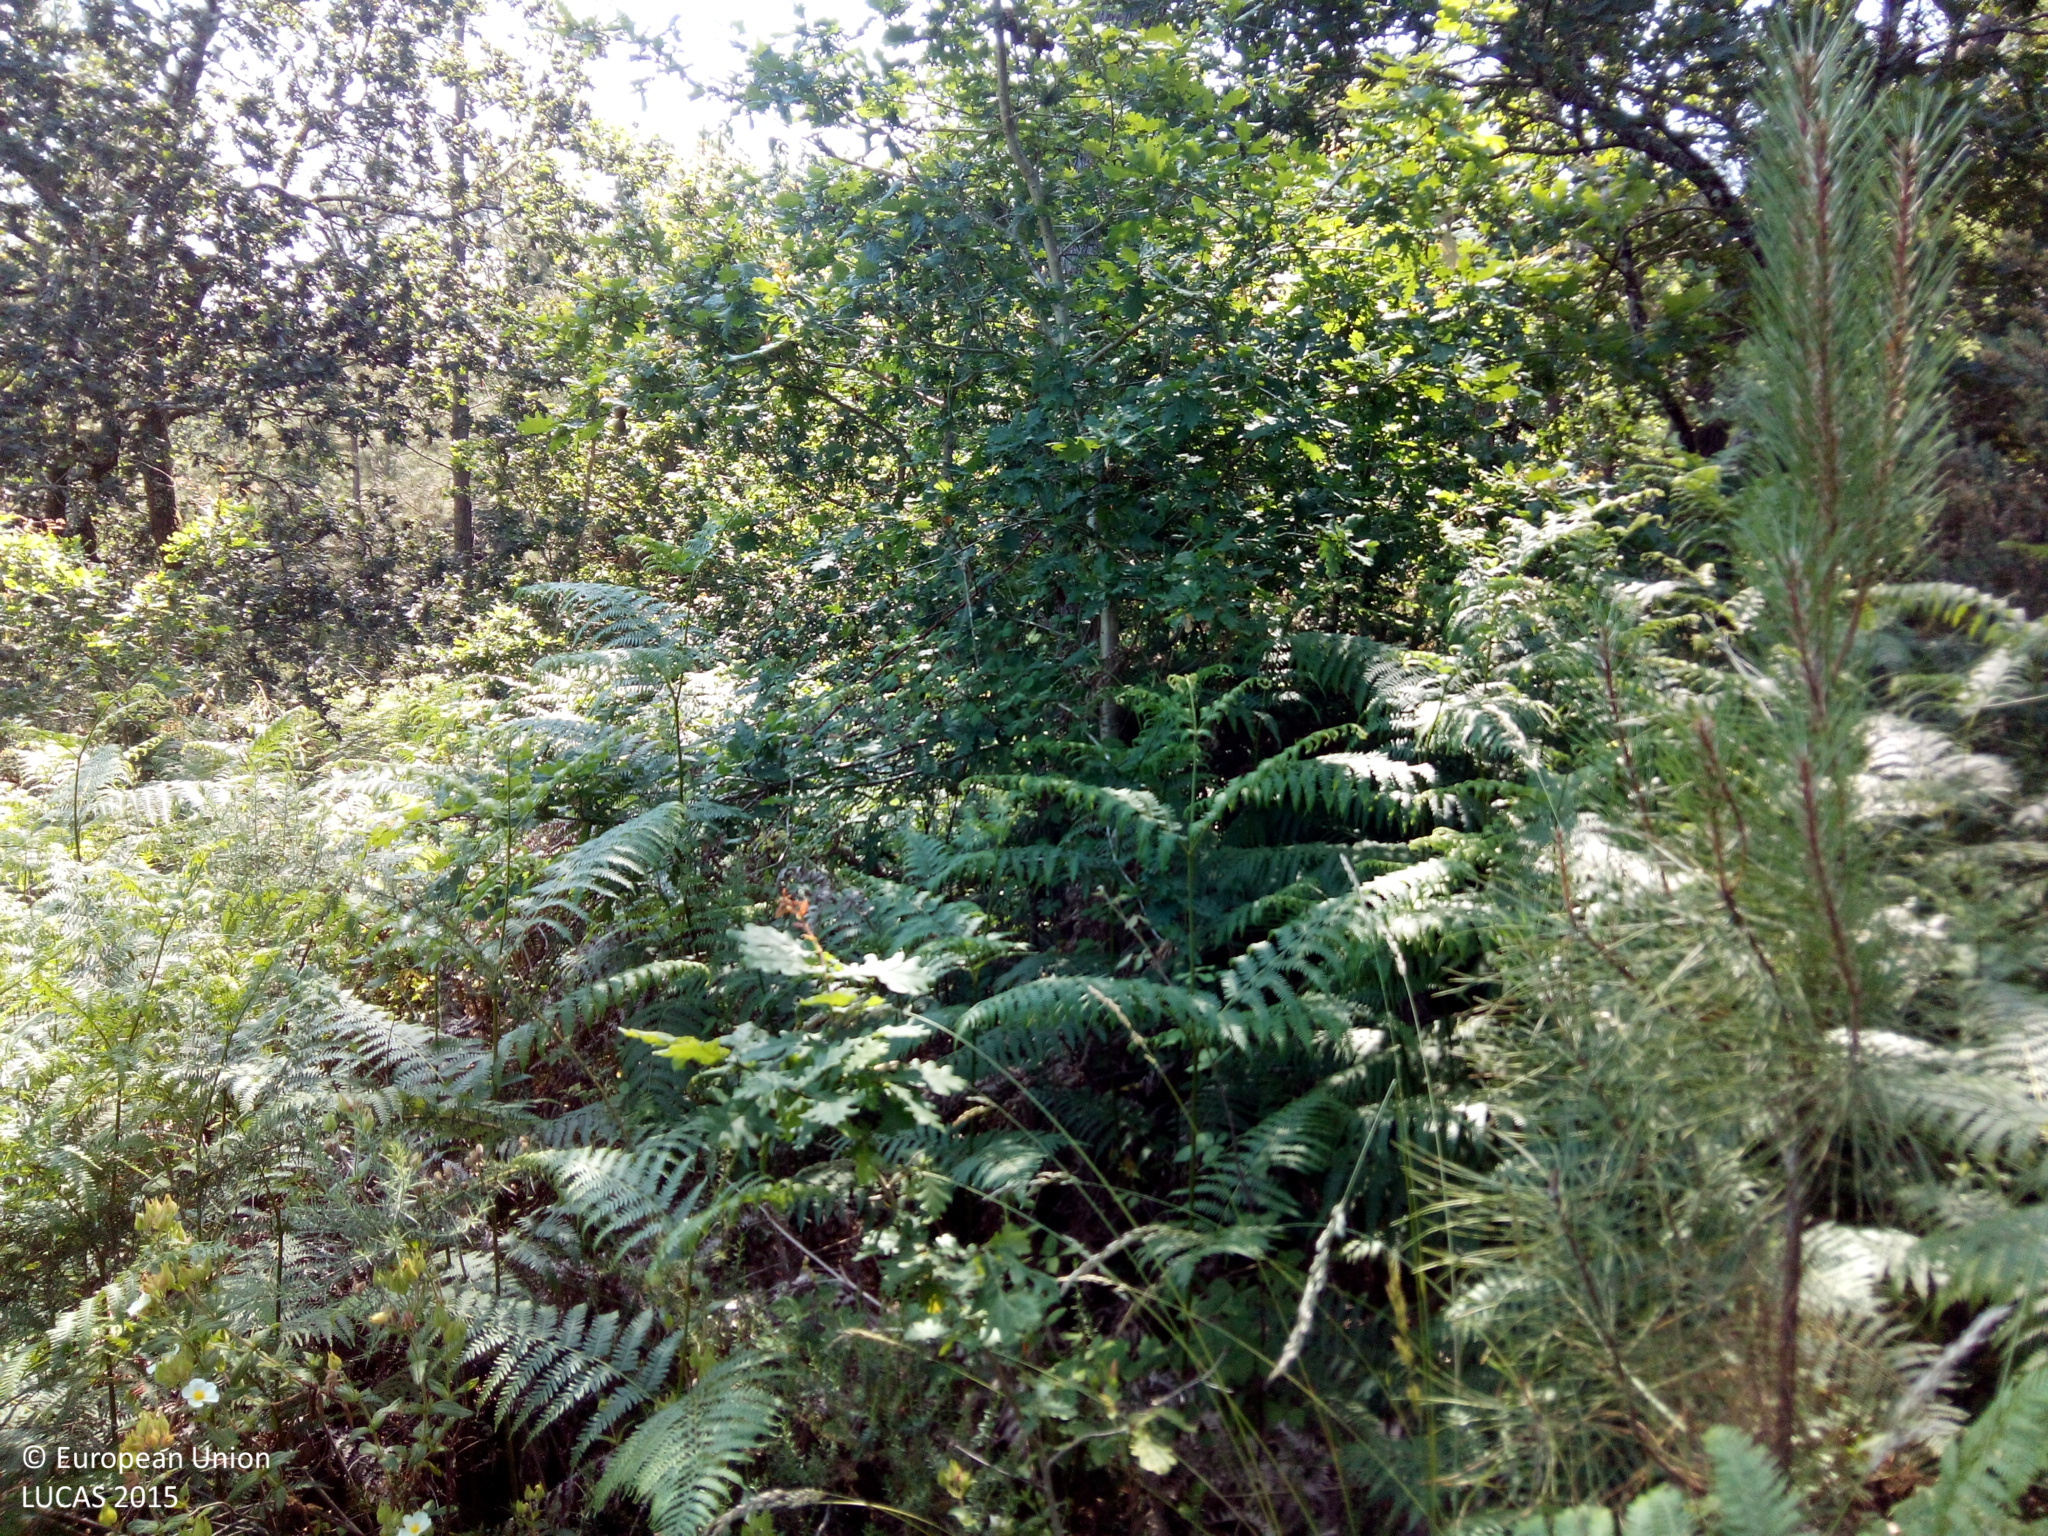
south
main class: Woodland
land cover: Broadleaved woodland
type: acidophilous oak and oak-birch forest
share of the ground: > 75 %
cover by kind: broadleaved forest trees 100 %
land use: Forestry
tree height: > 5 m
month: June
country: ES
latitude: 42.7454
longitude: -8.4869
